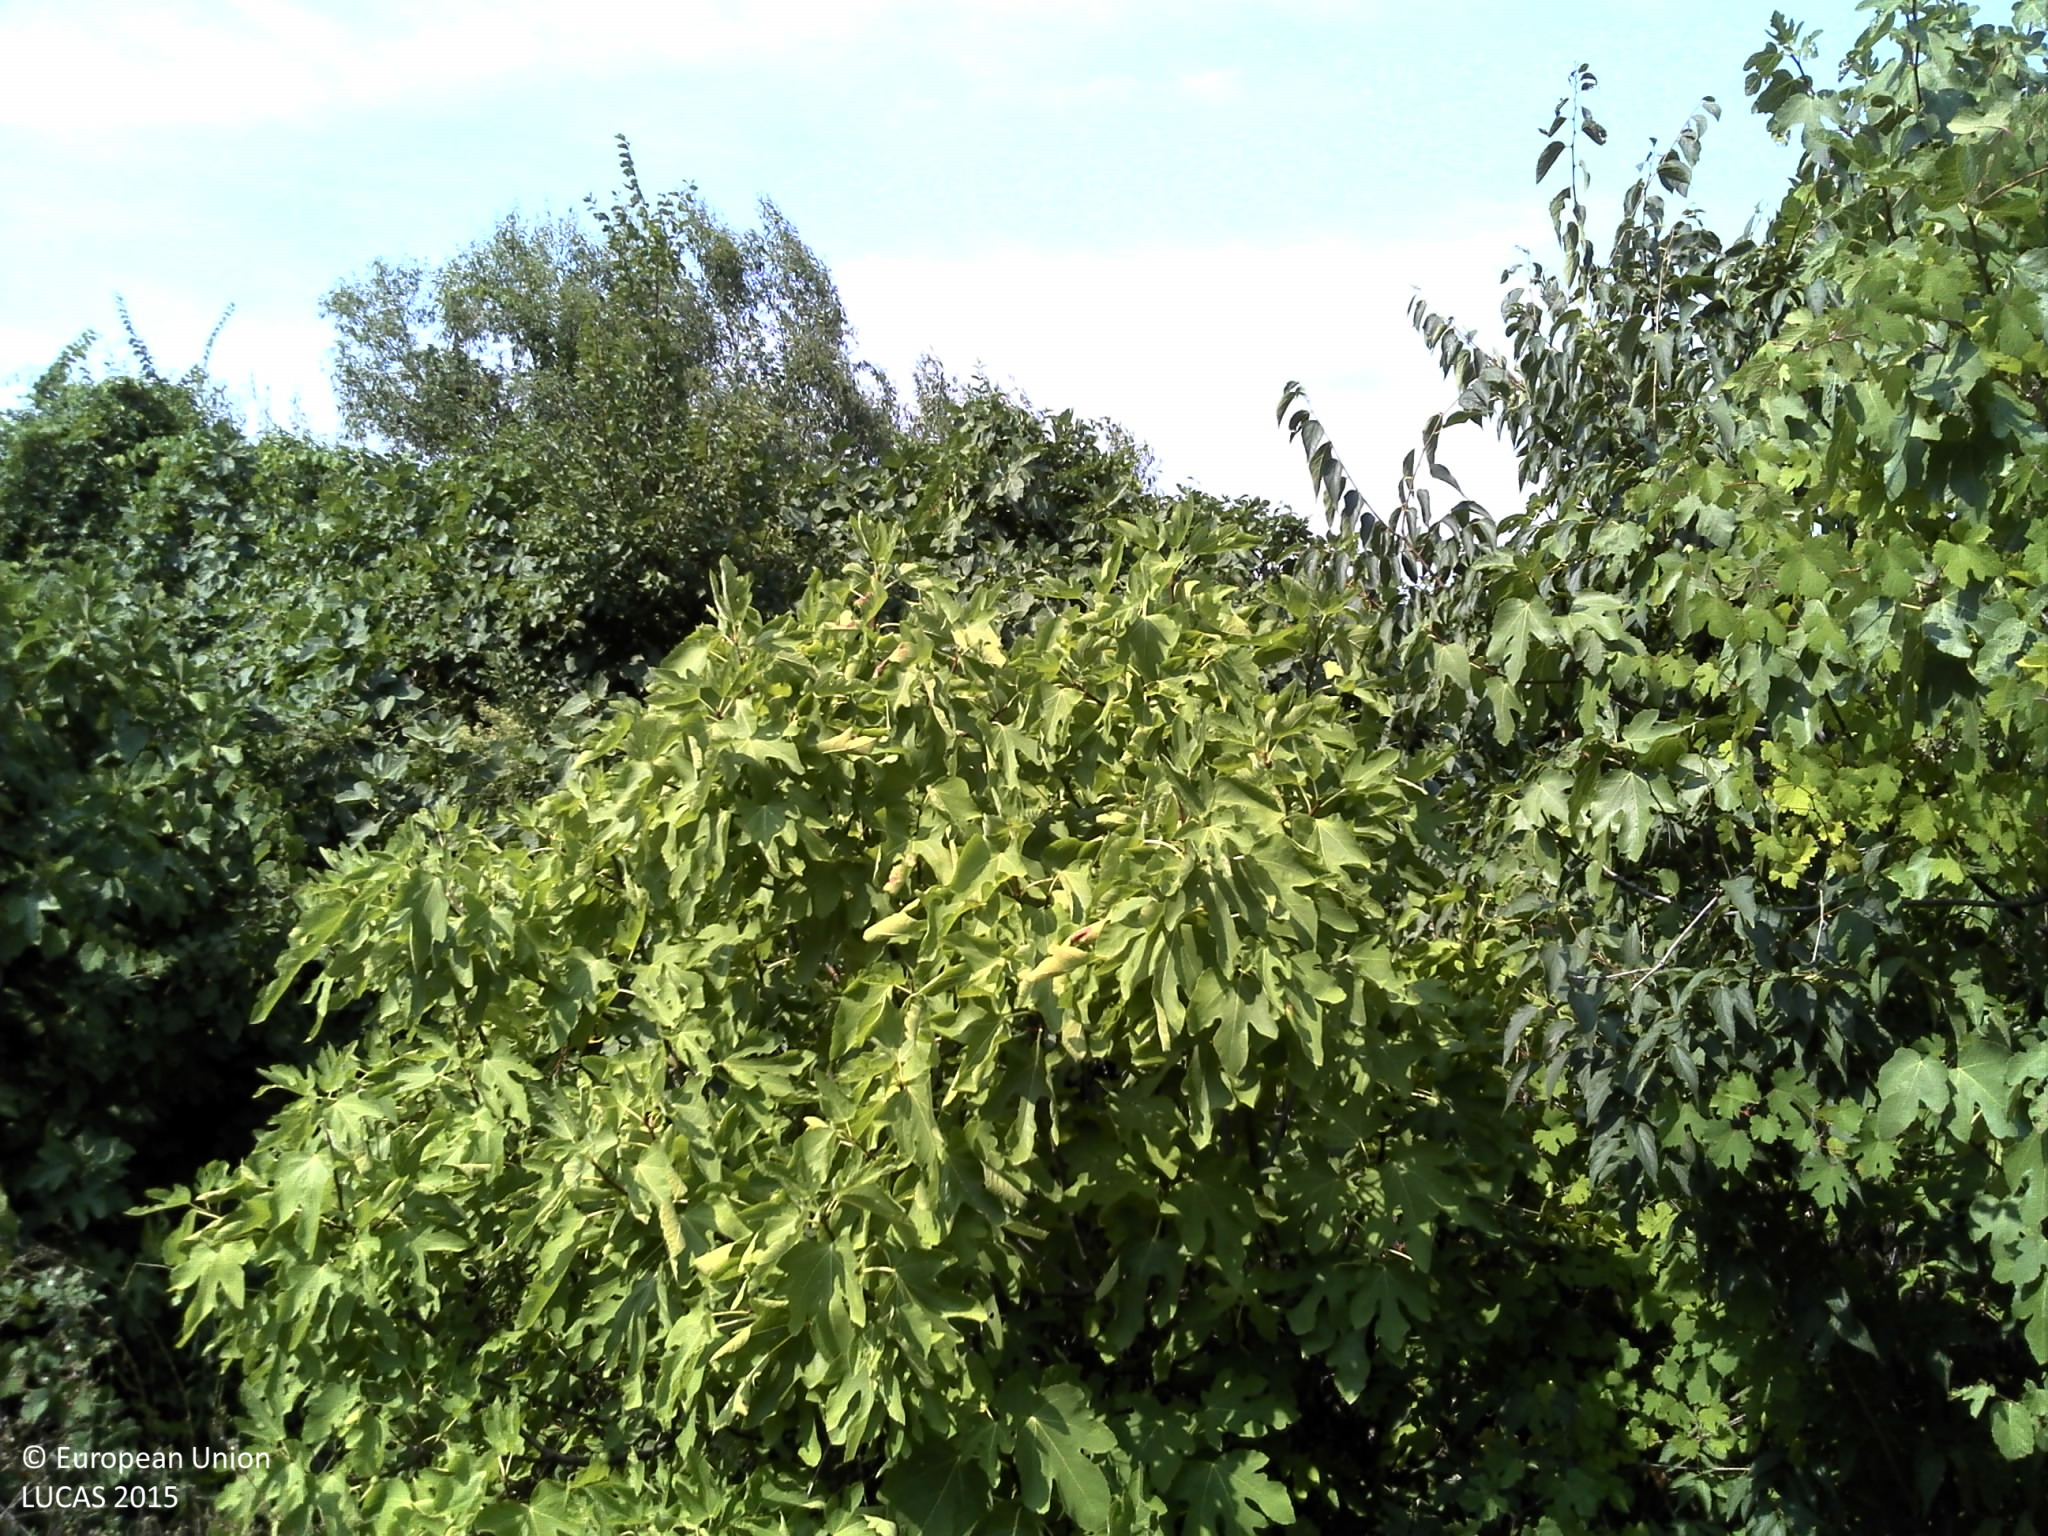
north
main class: Cropland
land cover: Other fruit trees and berries
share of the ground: 50 - 75 %
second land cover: Spontaneously vegetated surfaces
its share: > 75 %
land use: Agriculture (excluding fallow land and kitchen gardens)
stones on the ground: > 50 %
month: August
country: HR
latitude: 43.0918
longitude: 17.6202
